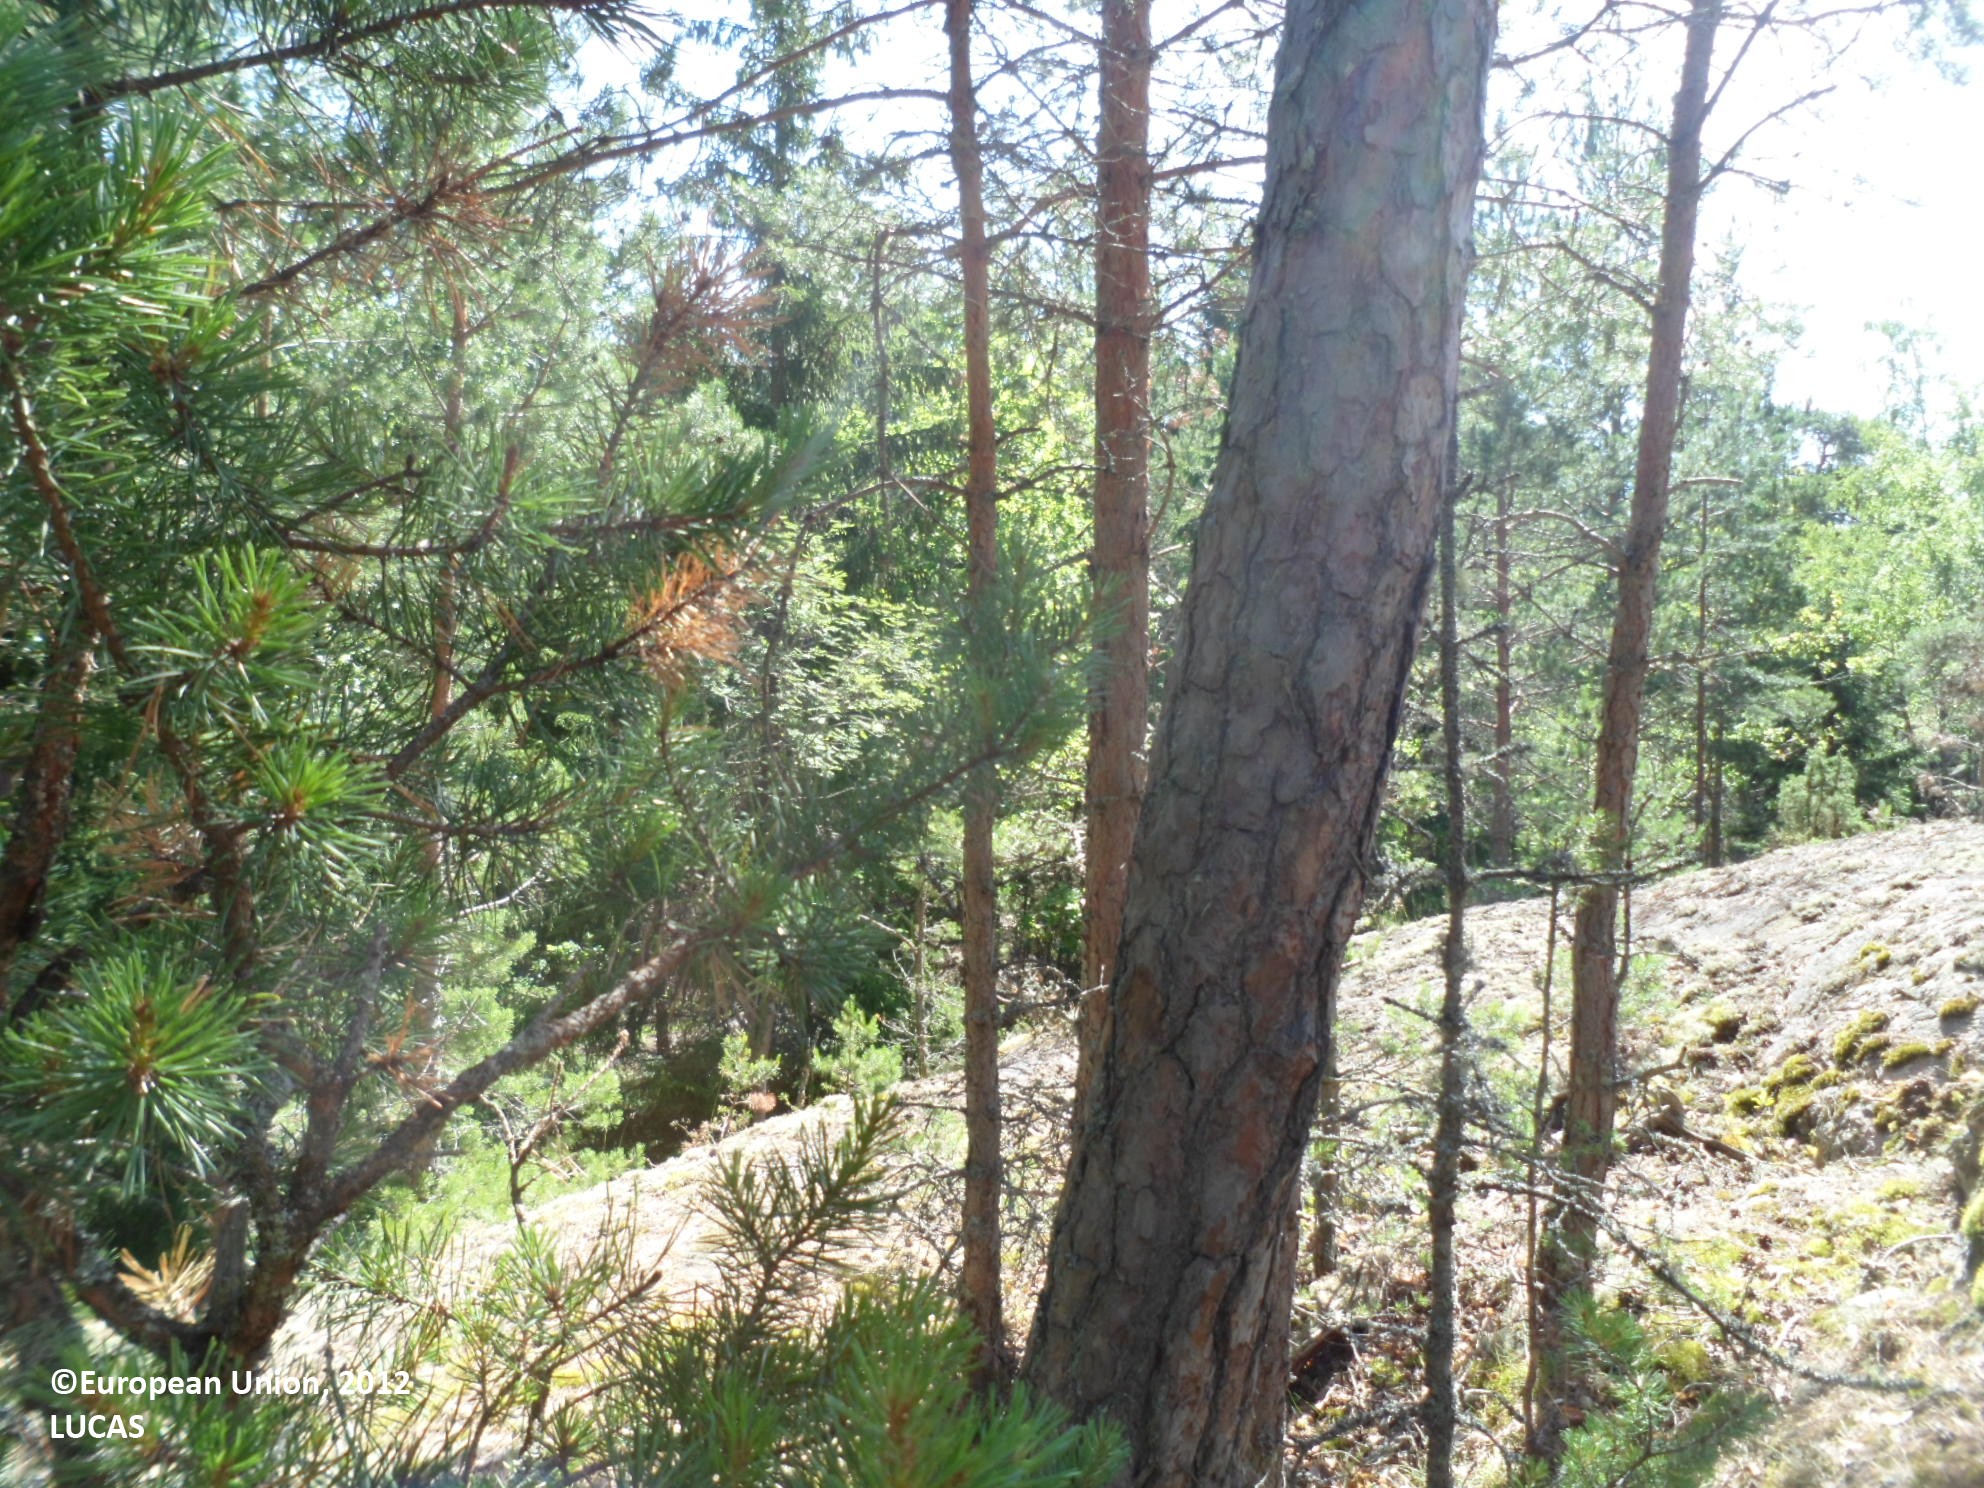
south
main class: Woodland
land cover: Pine dominated coniferous woodland
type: boreal forest
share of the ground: 50 - 75 %
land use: Forestry
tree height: > 5 m
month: July
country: SE
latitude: 59.3781
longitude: 18.5373
